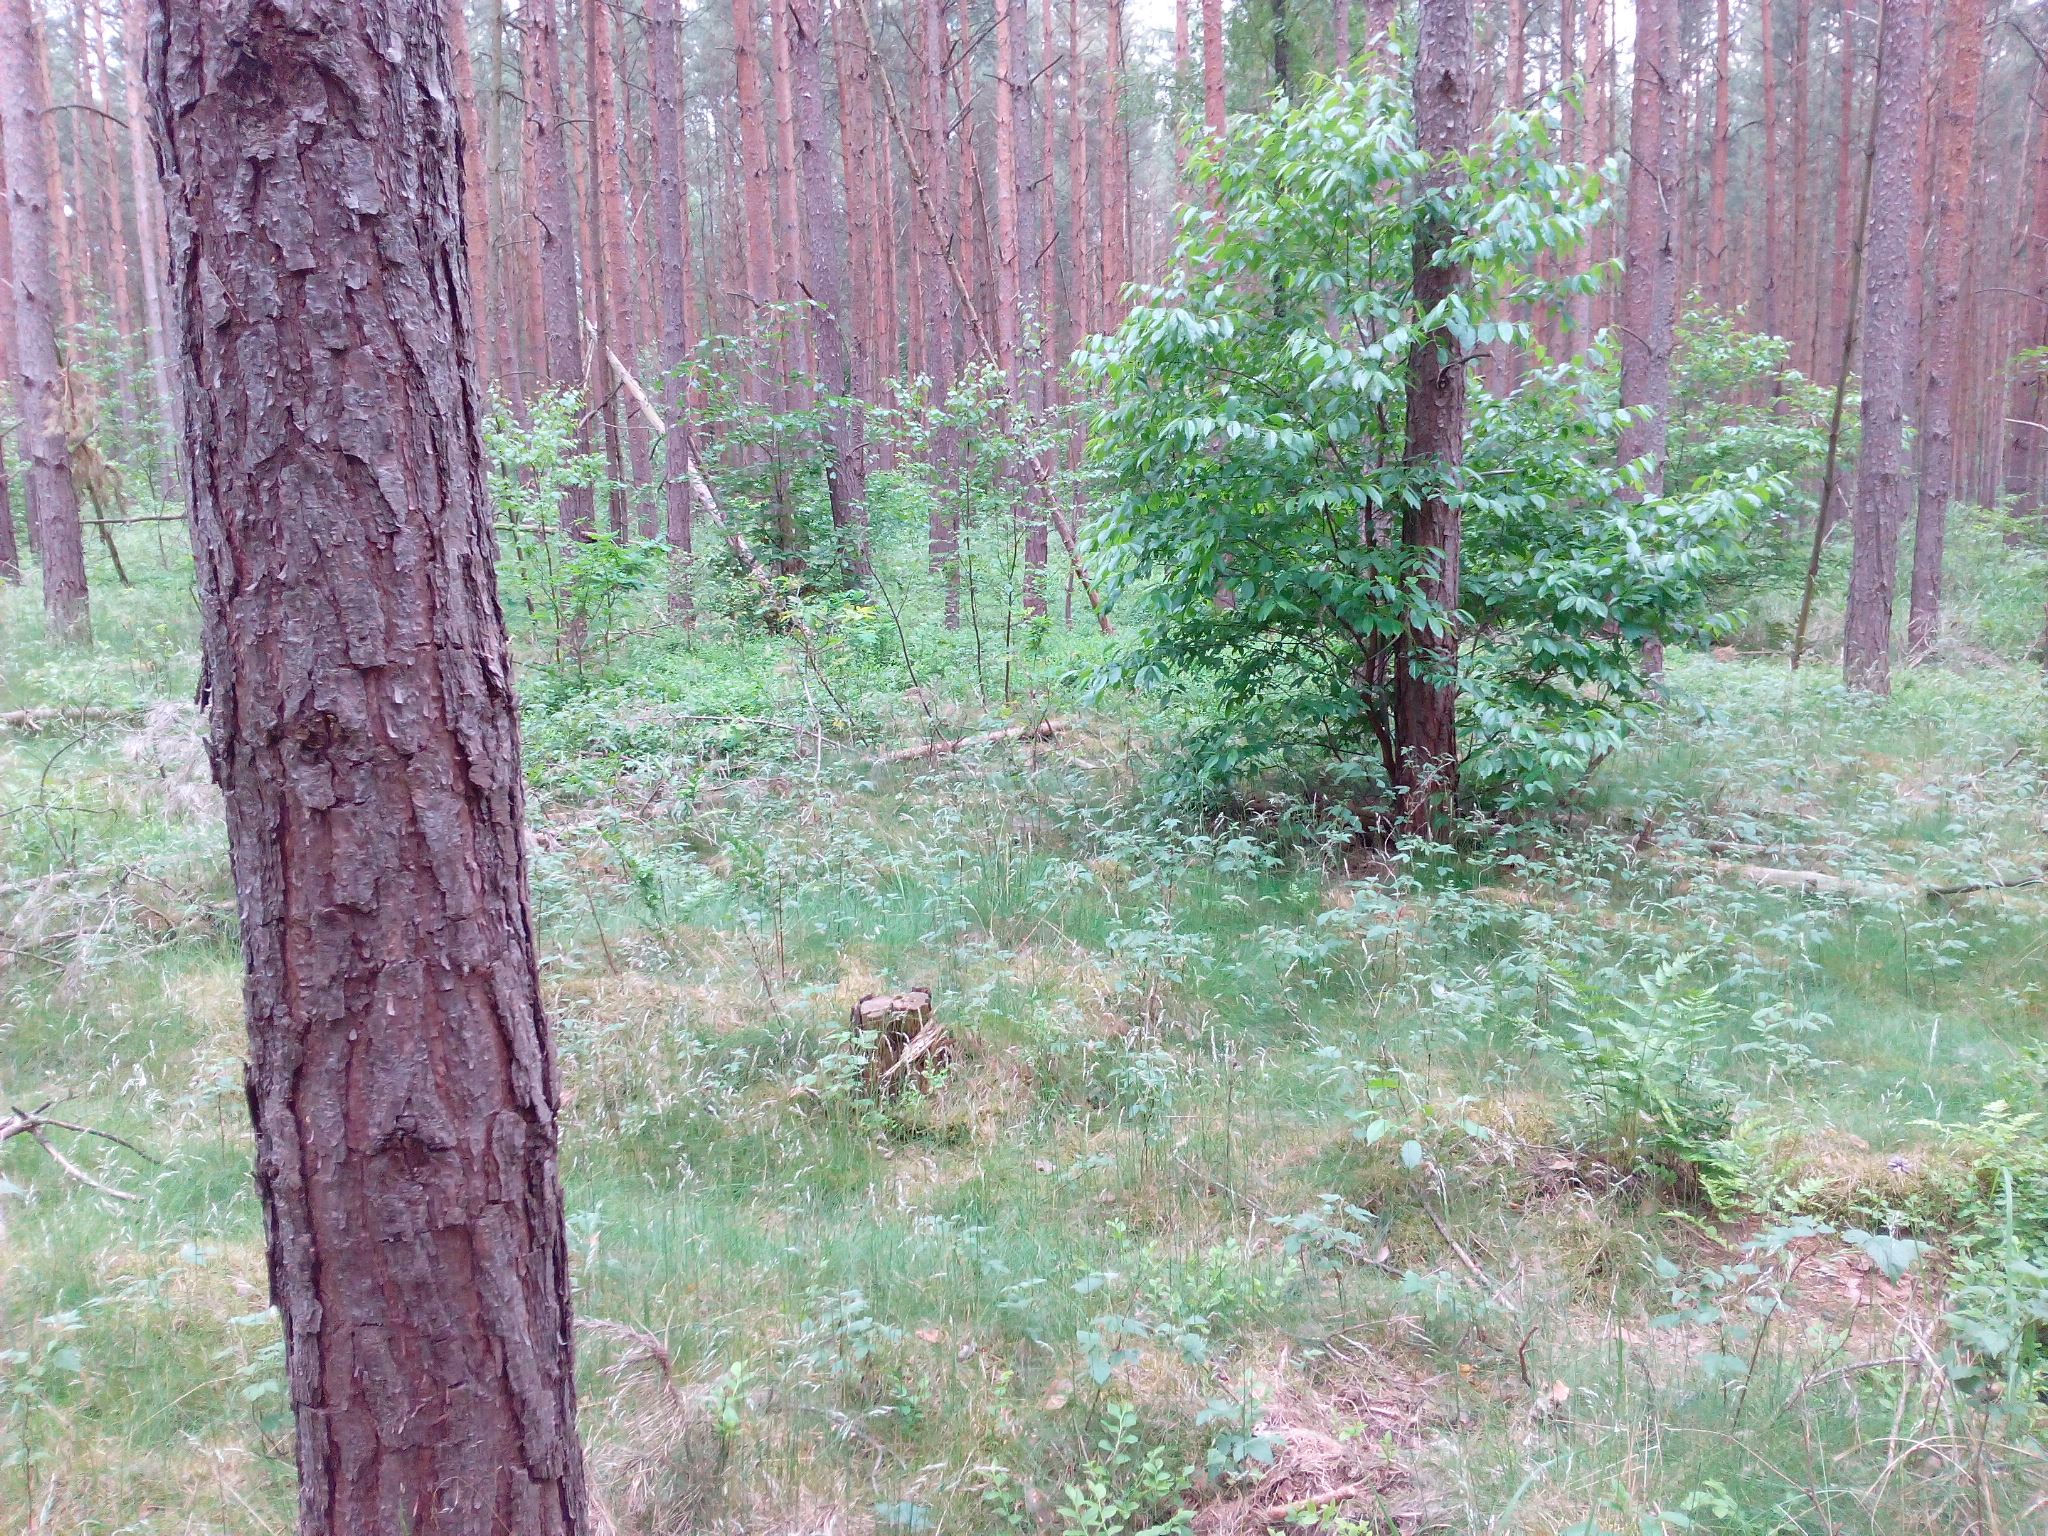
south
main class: Woodland
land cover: Pine dominated coniferous woodland
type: hemiboreal forest and nemoral coniferous forest and mixed broadleaved-coniferous forest
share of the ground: 50 - 75 %
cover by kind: coniferous forest trees 60 %, herbaceous plants 15 %, lichens and mosses 15 %, shrubs 10 %
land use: Forestry
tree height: > 5 m
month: June
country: DE
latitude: 53.0078
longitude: 13.5620
